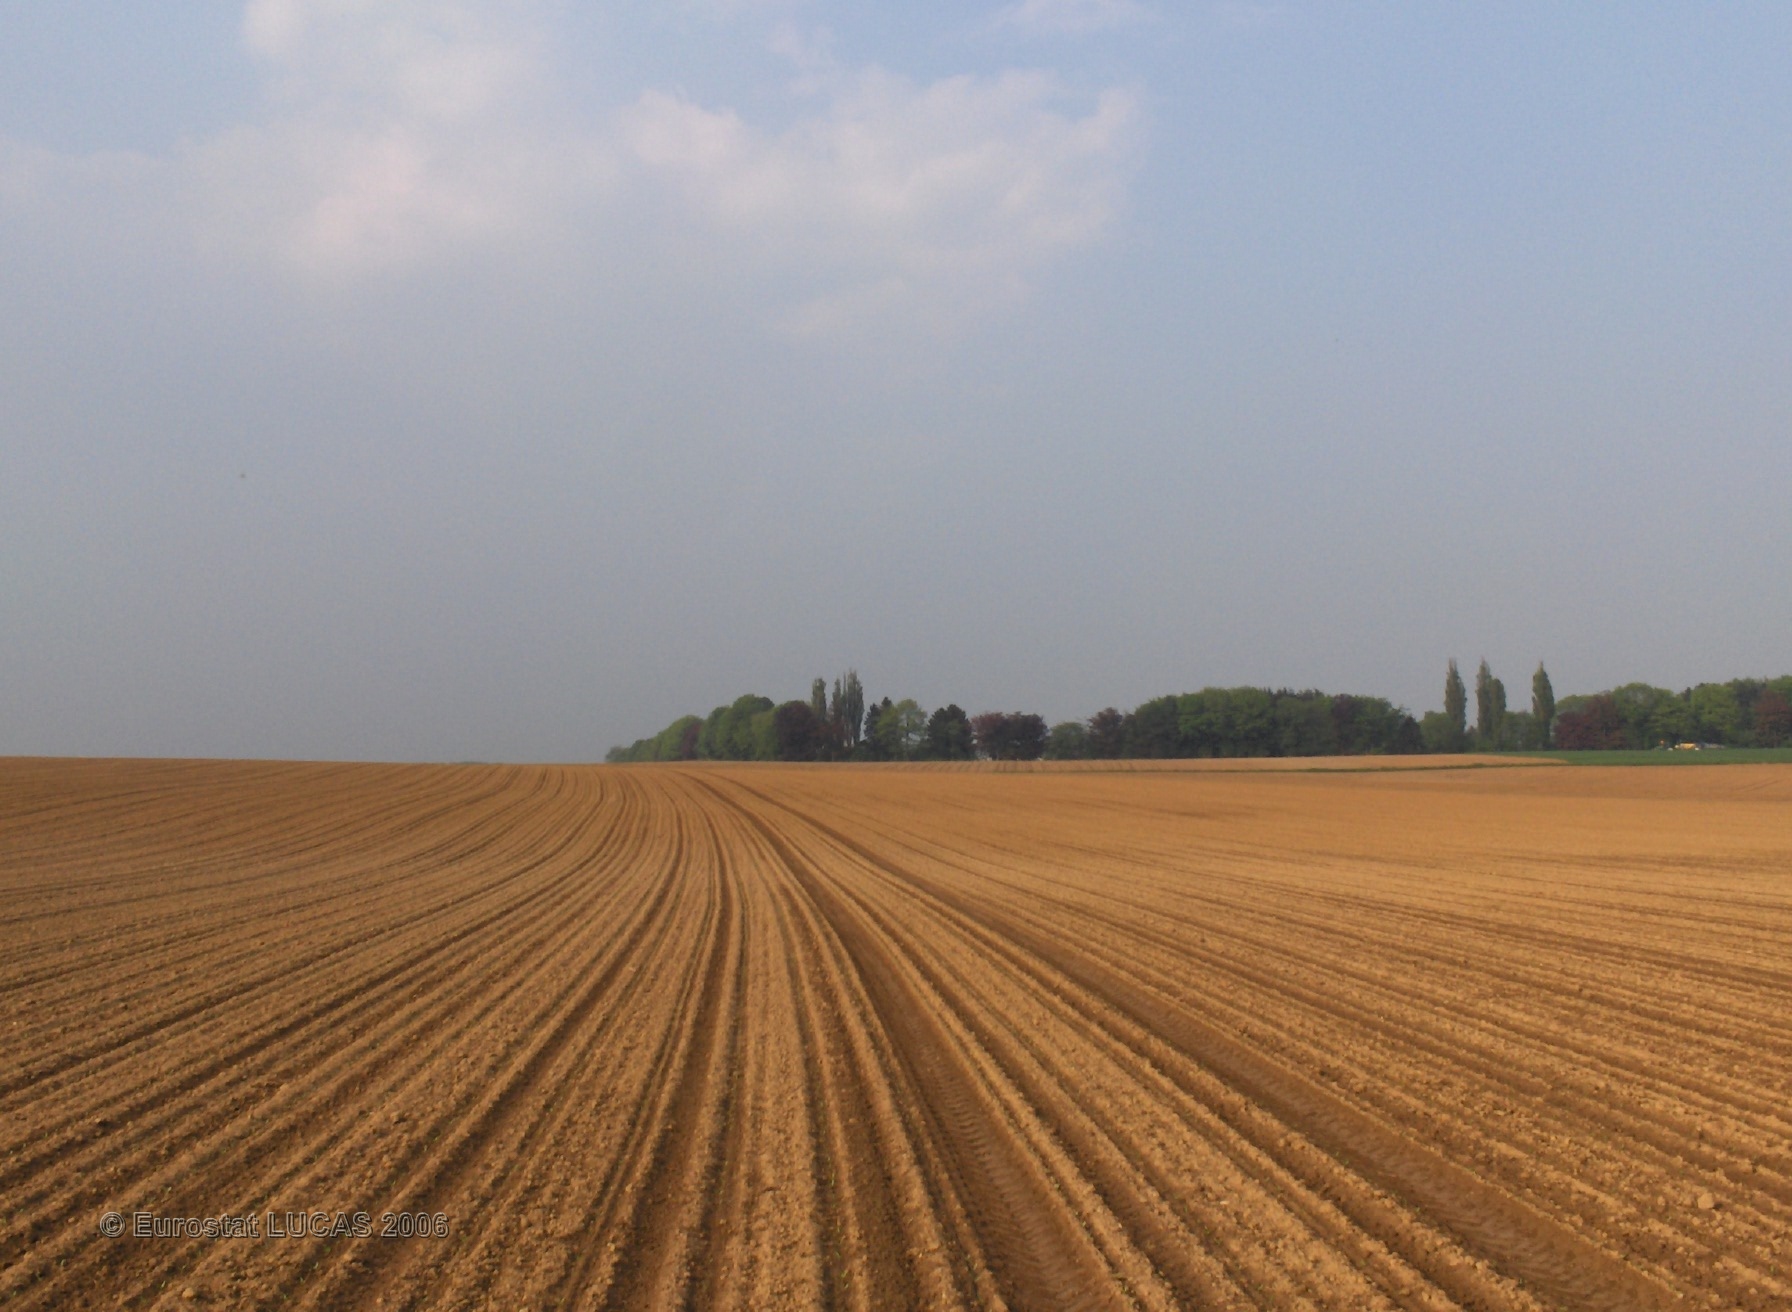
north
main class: Cropland
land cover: Sugar beet
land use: Agriculture (excluding fallow land and kitchen gardens)
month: May
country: BE
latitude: 50.6832
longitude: 4.5185
